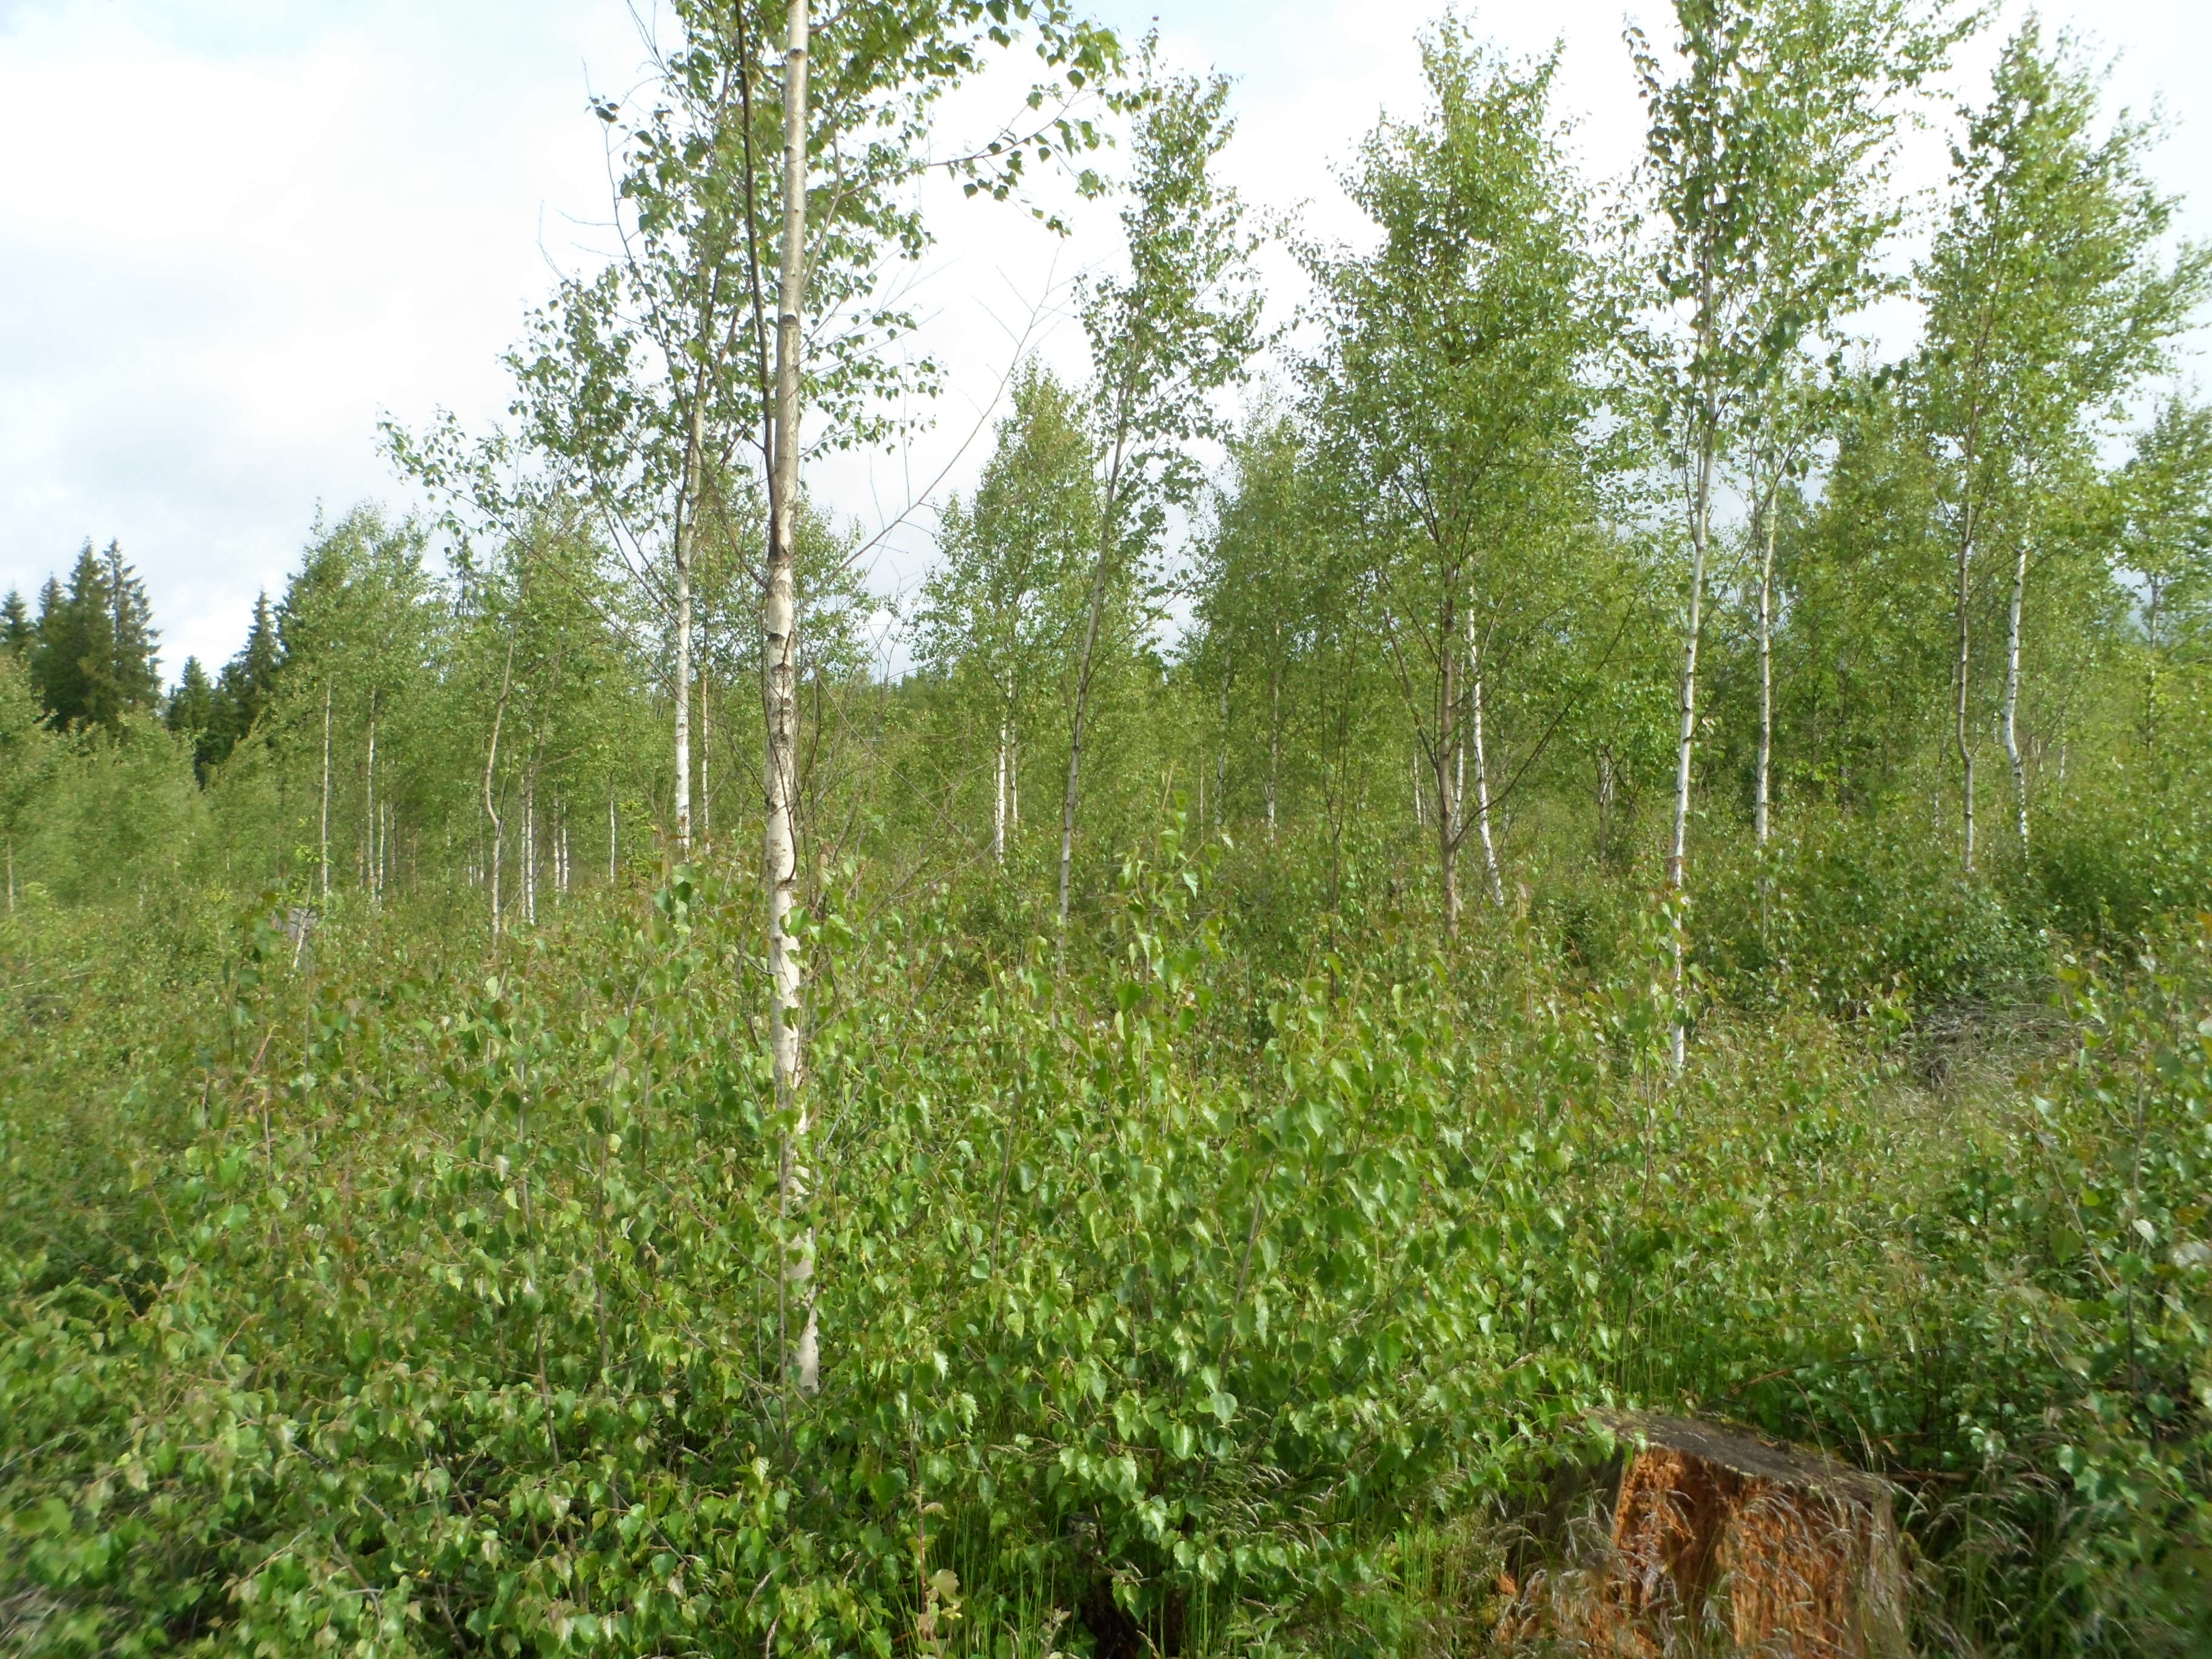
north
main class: Woodland
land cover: Broadleaved woodland
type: boreal forest
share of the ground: > 75 %
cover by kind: broadleaved forest trees 70 %, herbaceous plants 15 %, coniferous forest trees 10 %, shrubs 5 %
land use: Forestry
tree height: < 5 m
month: June
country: SE
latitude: 56.9322
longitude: 14.6473
